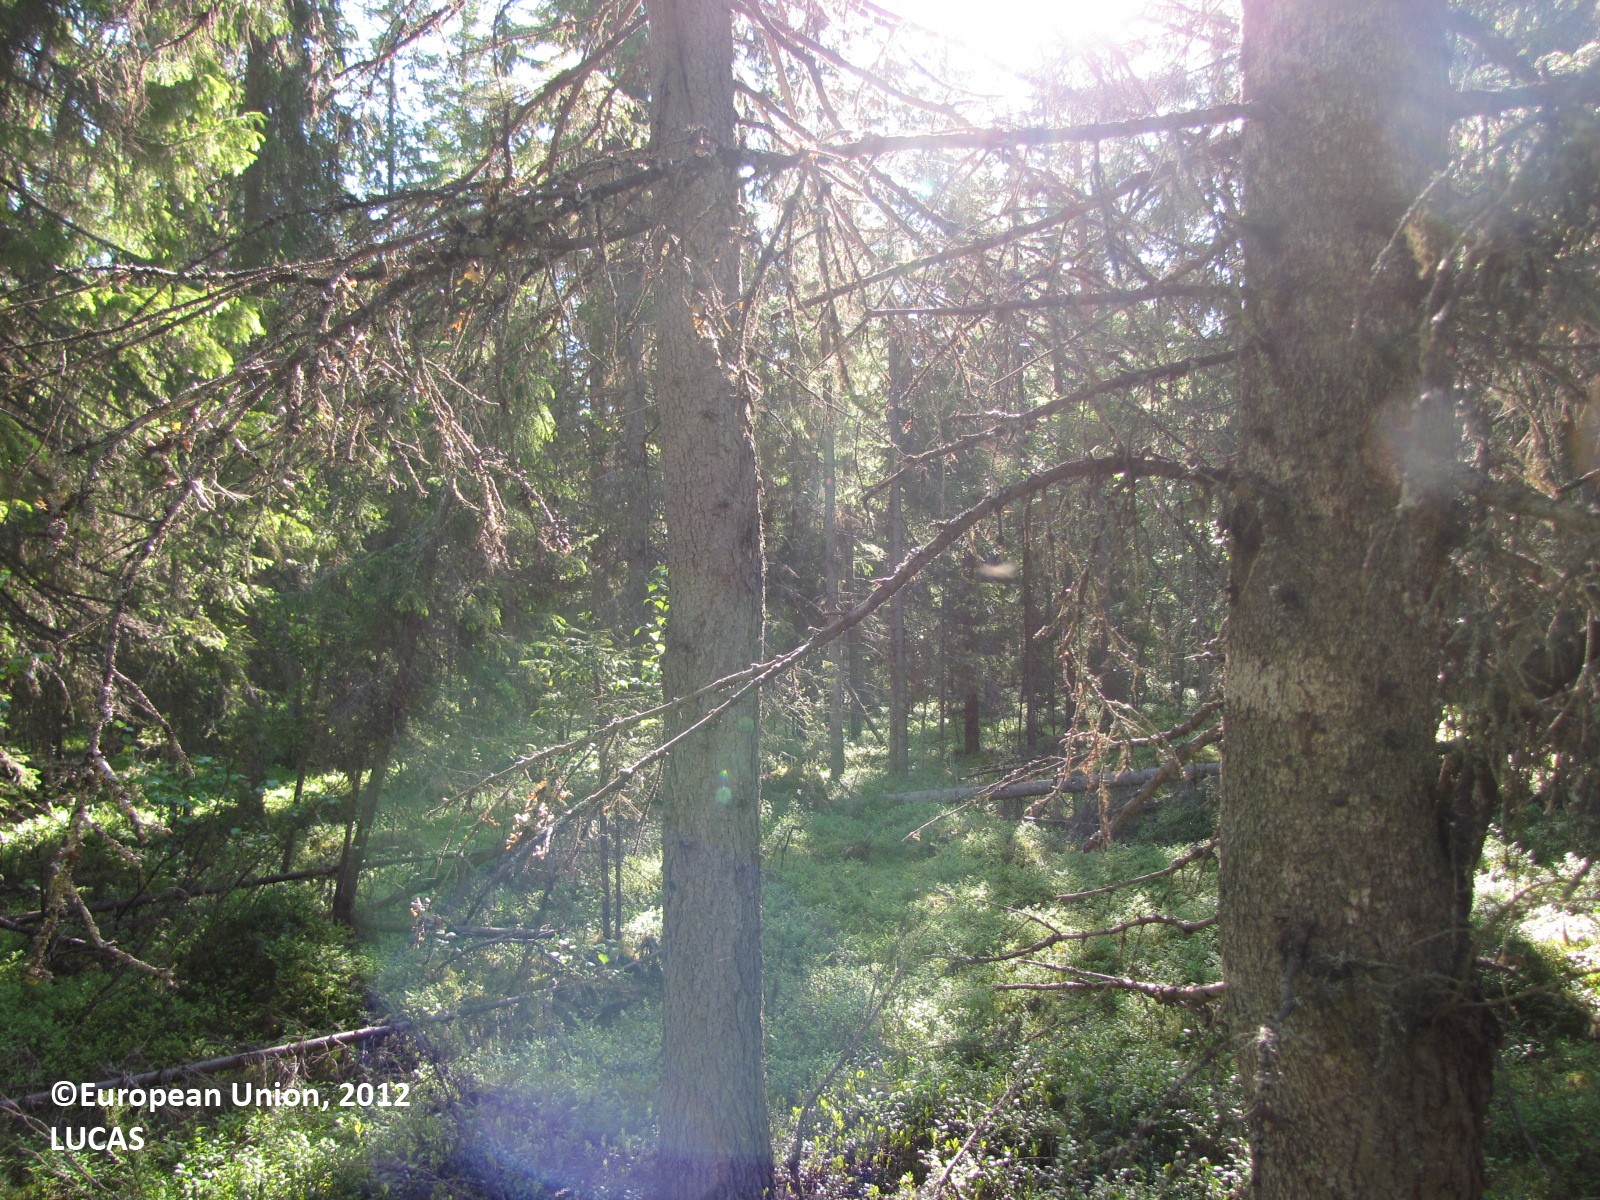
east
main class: Woodland
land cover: Spruce dominated coniferous woodland
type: boreal forest
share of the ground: 50 - 75 %
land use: Forestry
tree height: > 5 m
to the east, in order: Spruce dominated coniferous woodland; Tracks; Electric lines; Spruce dominated coniferous woodland
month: July
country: FI
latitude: 66.4170
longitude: 24.7670
